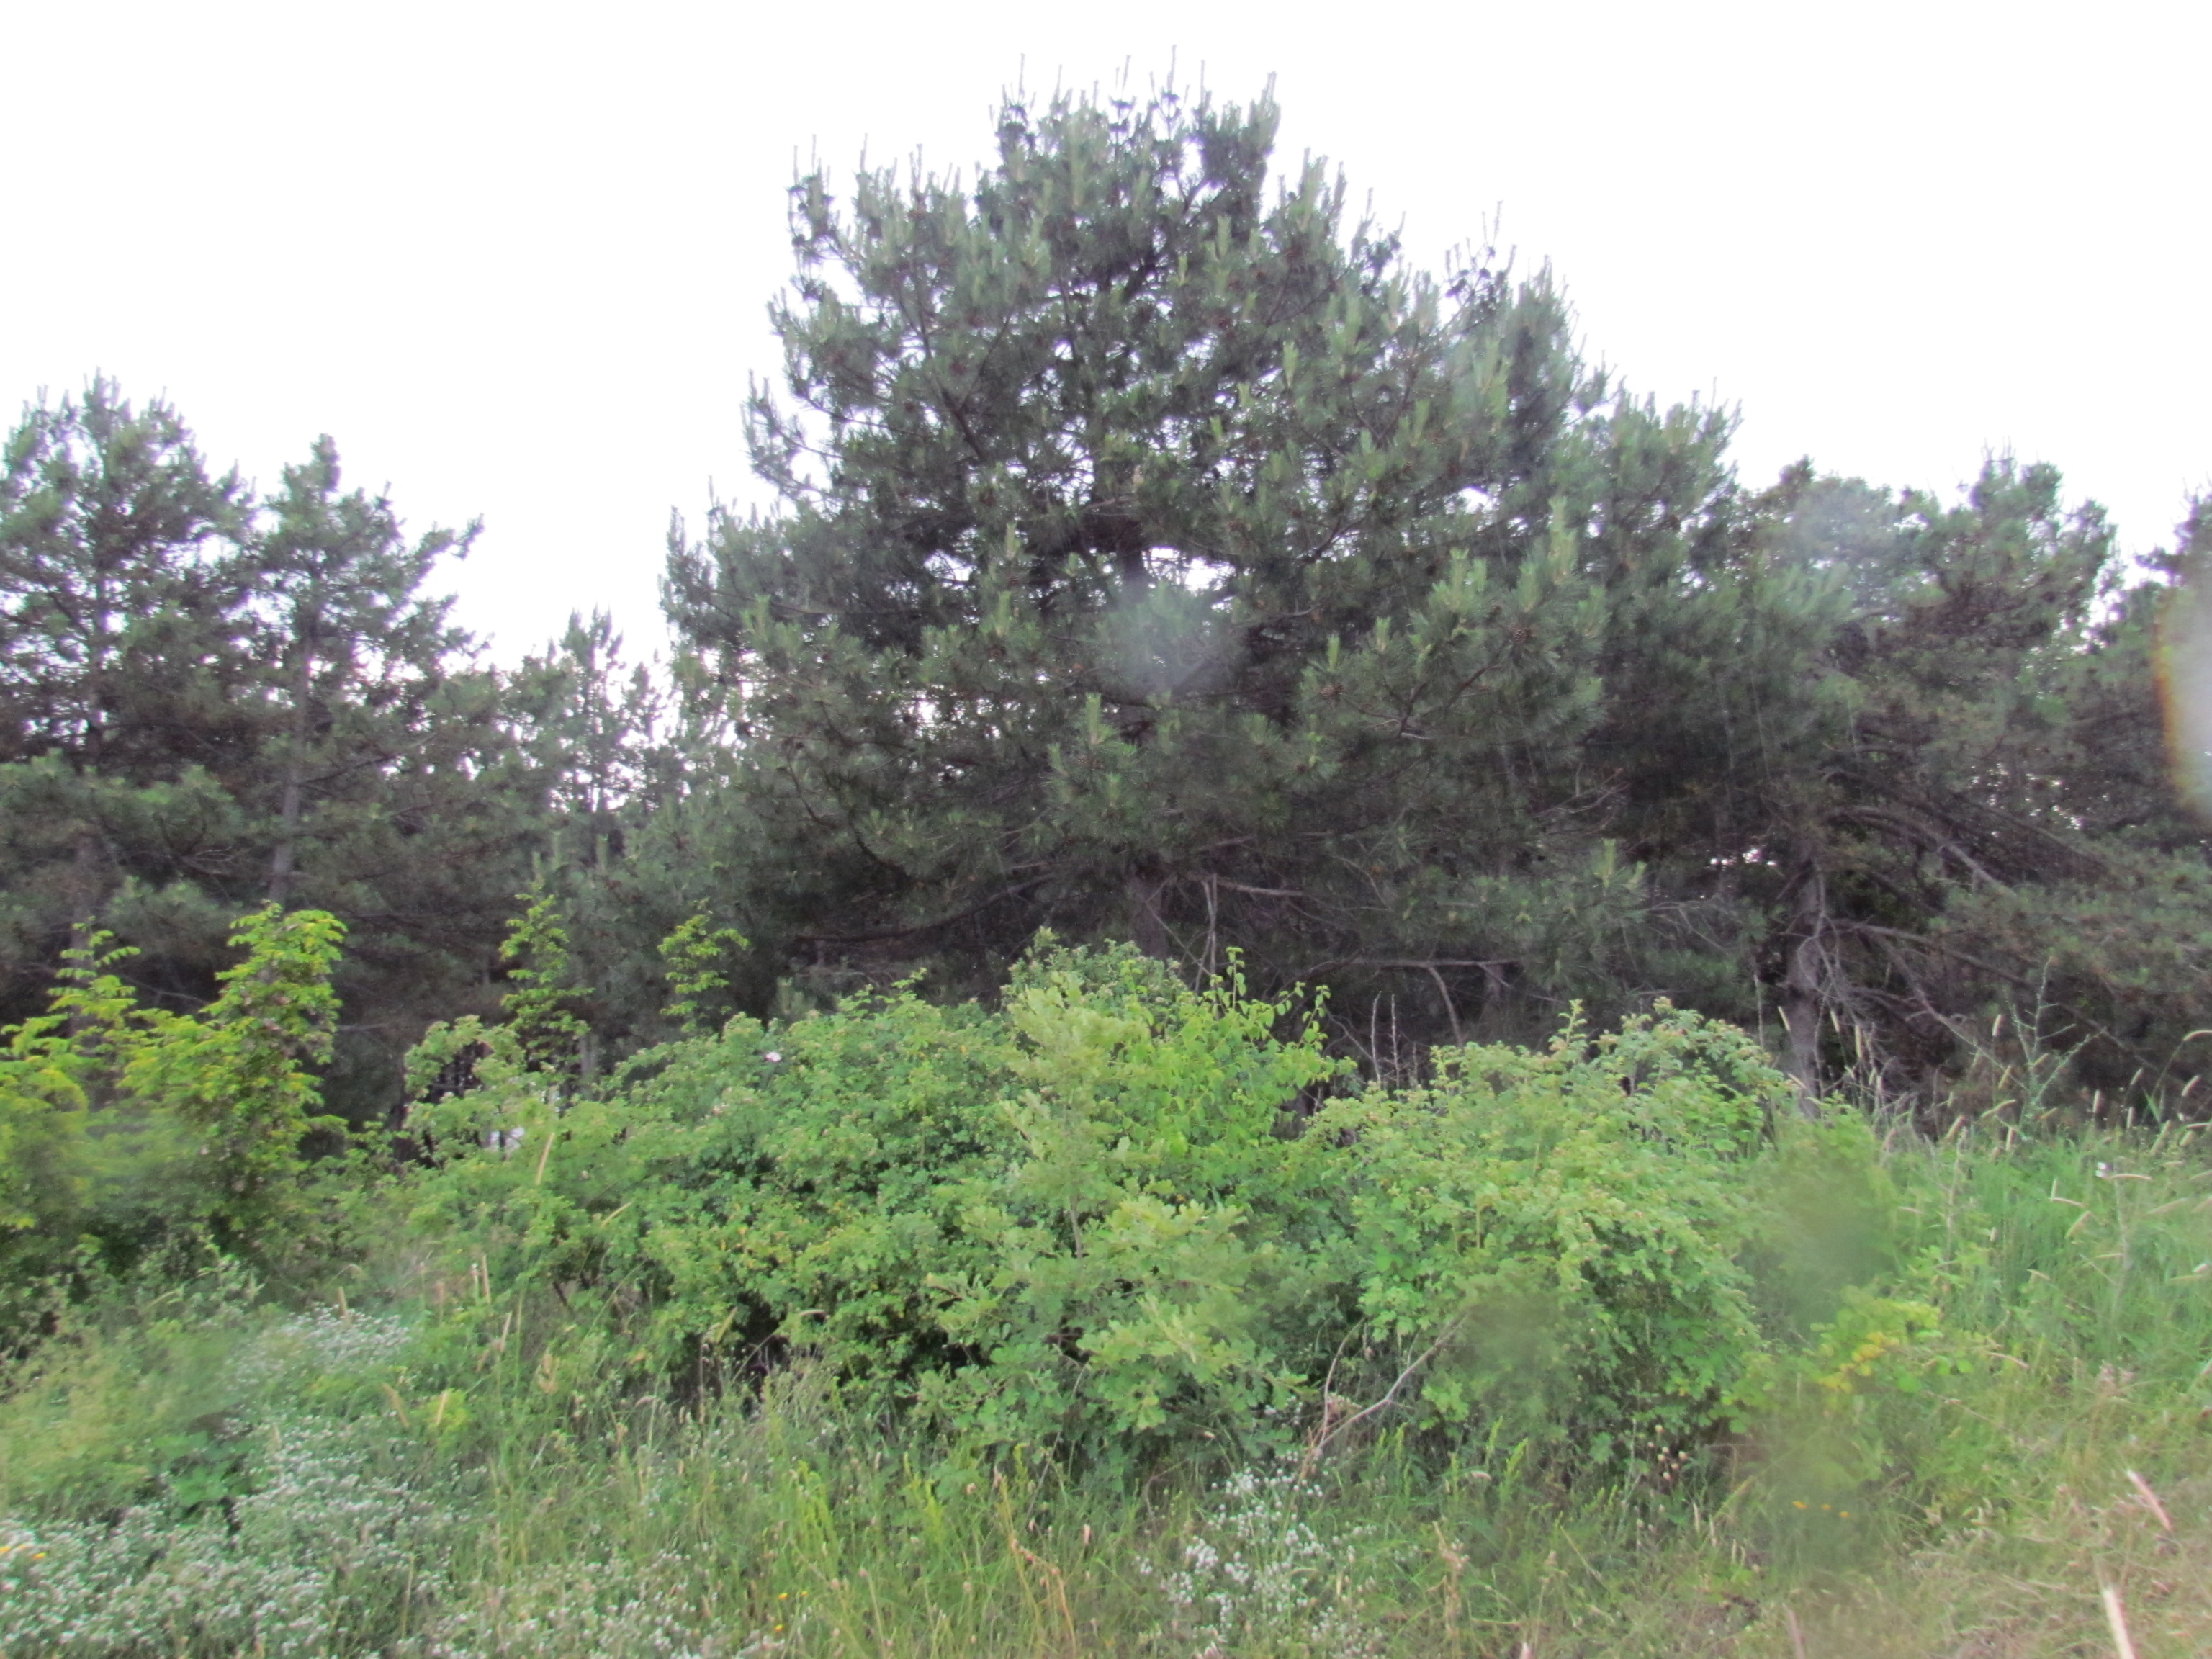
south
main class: Grassland
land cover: Grassland with sparse tree/shrub cover
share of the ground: > 75 %
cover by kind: herbaceous plants 90 %, broadleaved forest trees 5 %, shrubs 5 %
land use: Semi-natural and natural areas not in use
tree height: > 5 m
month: June
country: BG
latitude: 42.7050
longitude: 27.7946
